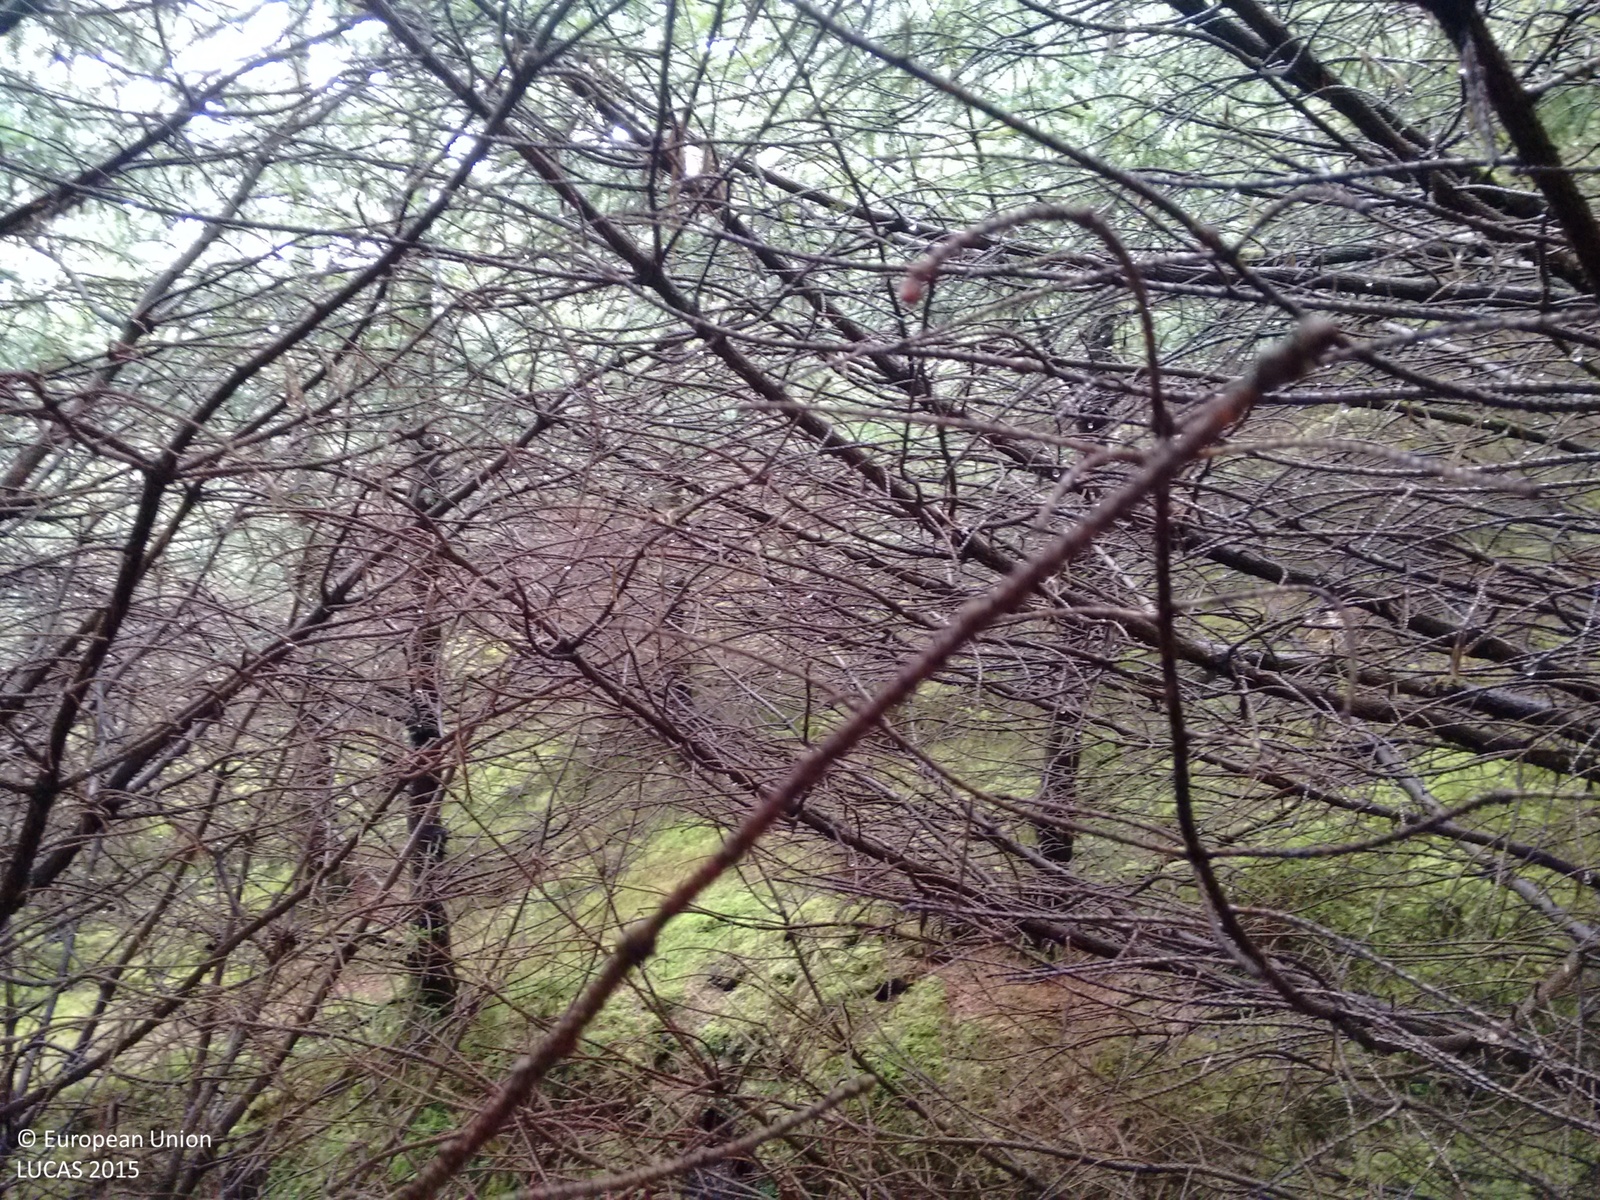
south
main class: Woodland
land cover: Spruce dominated coniferous woodland
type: exotic forest
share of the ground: > 75 %
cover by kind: coniferous forest trees 100 %
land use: Forestry
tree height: > 5 m
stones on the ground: < 10 %
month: May
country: GB
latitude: 56.1098
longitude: -5.1152
